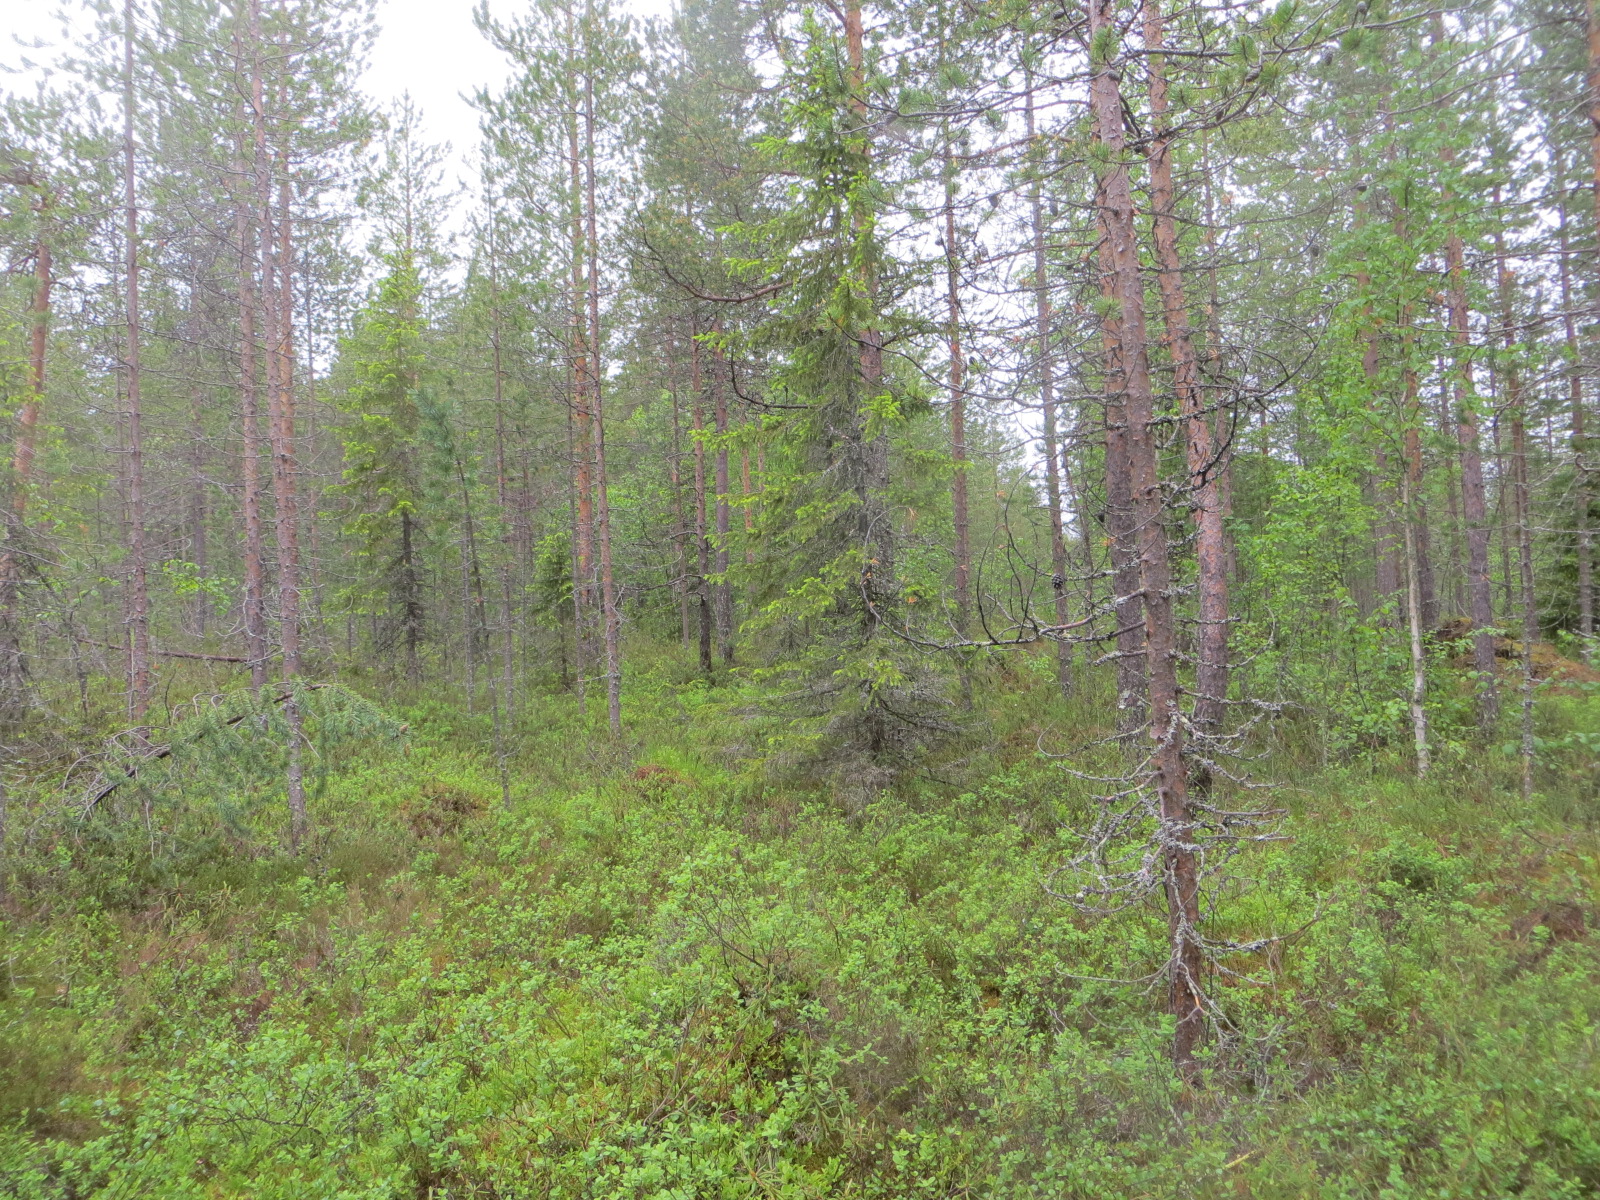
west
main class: Woodland
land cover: Pine dominated coniferous woodland
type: boreal forest
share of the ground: > 75 %
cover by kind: coniferous forest trees 75 %, shrubs 20 %, lichens and mosses 5 %
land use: Forestry
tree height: > 5 m
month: June
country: FI
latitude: 66.4476
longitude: 26.6195
